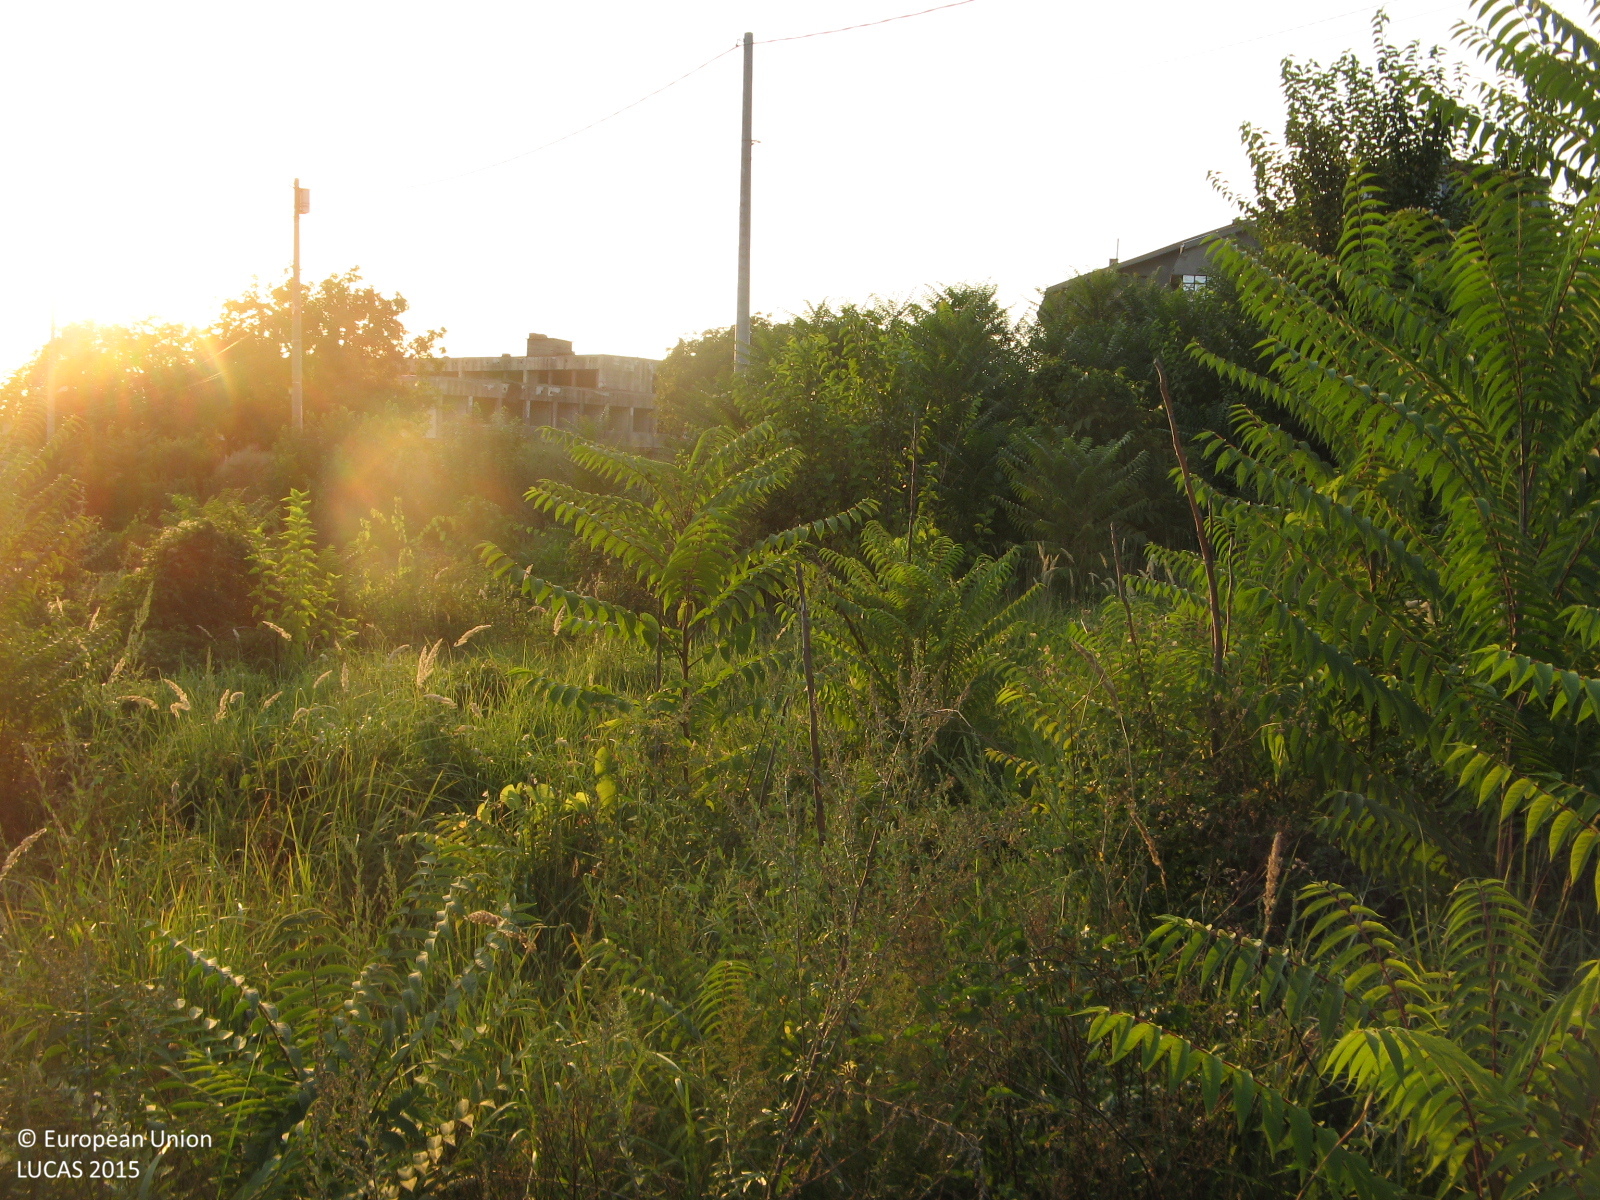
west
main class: Shrubland
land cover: Shrubland without tree cover
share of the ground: > 75 %
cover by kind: shrubs 90 %, herbaceous plants 10 %
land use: Abandoned areas
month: September
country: BG
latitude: 43.8235
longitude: 25.9485
